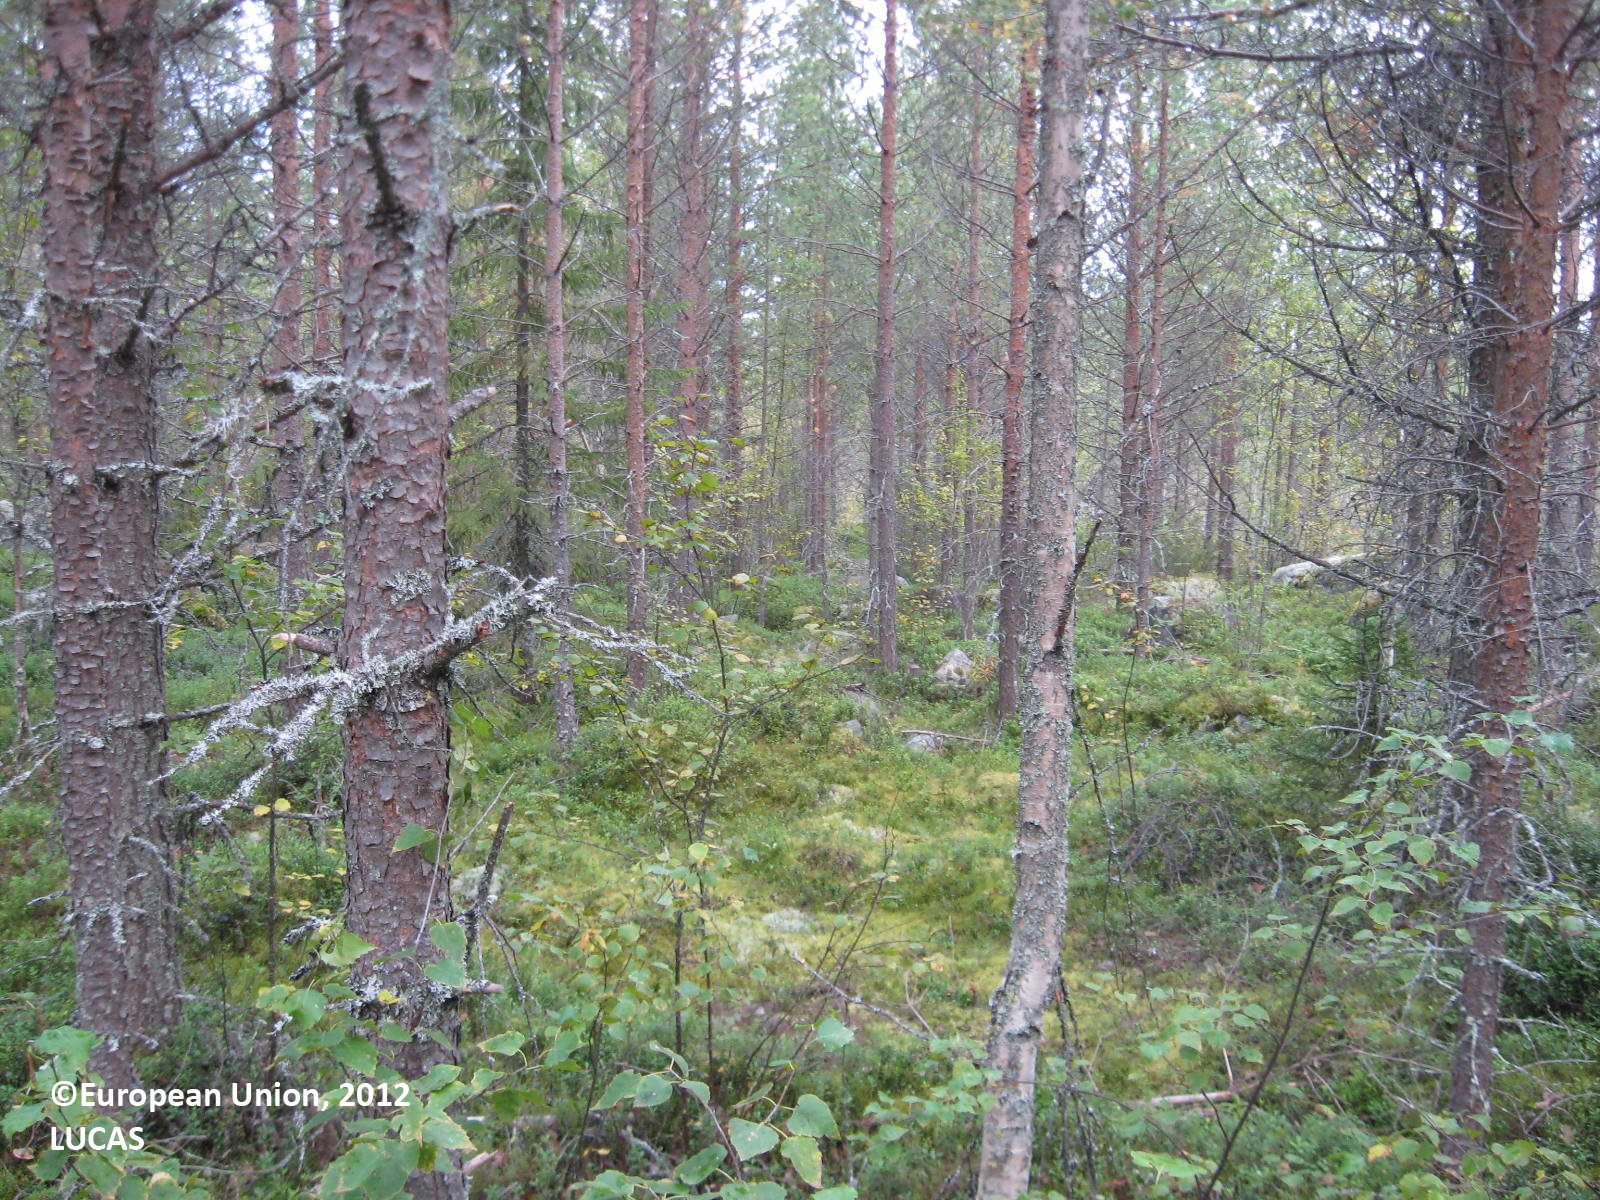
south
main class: Woodland
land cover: Pine dominated coniferous woodland
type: boreal forest
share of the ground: > 75 %
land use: Forestry
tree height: > 5 m
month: August
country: FI
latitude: 63.7536
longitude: 29.7518
